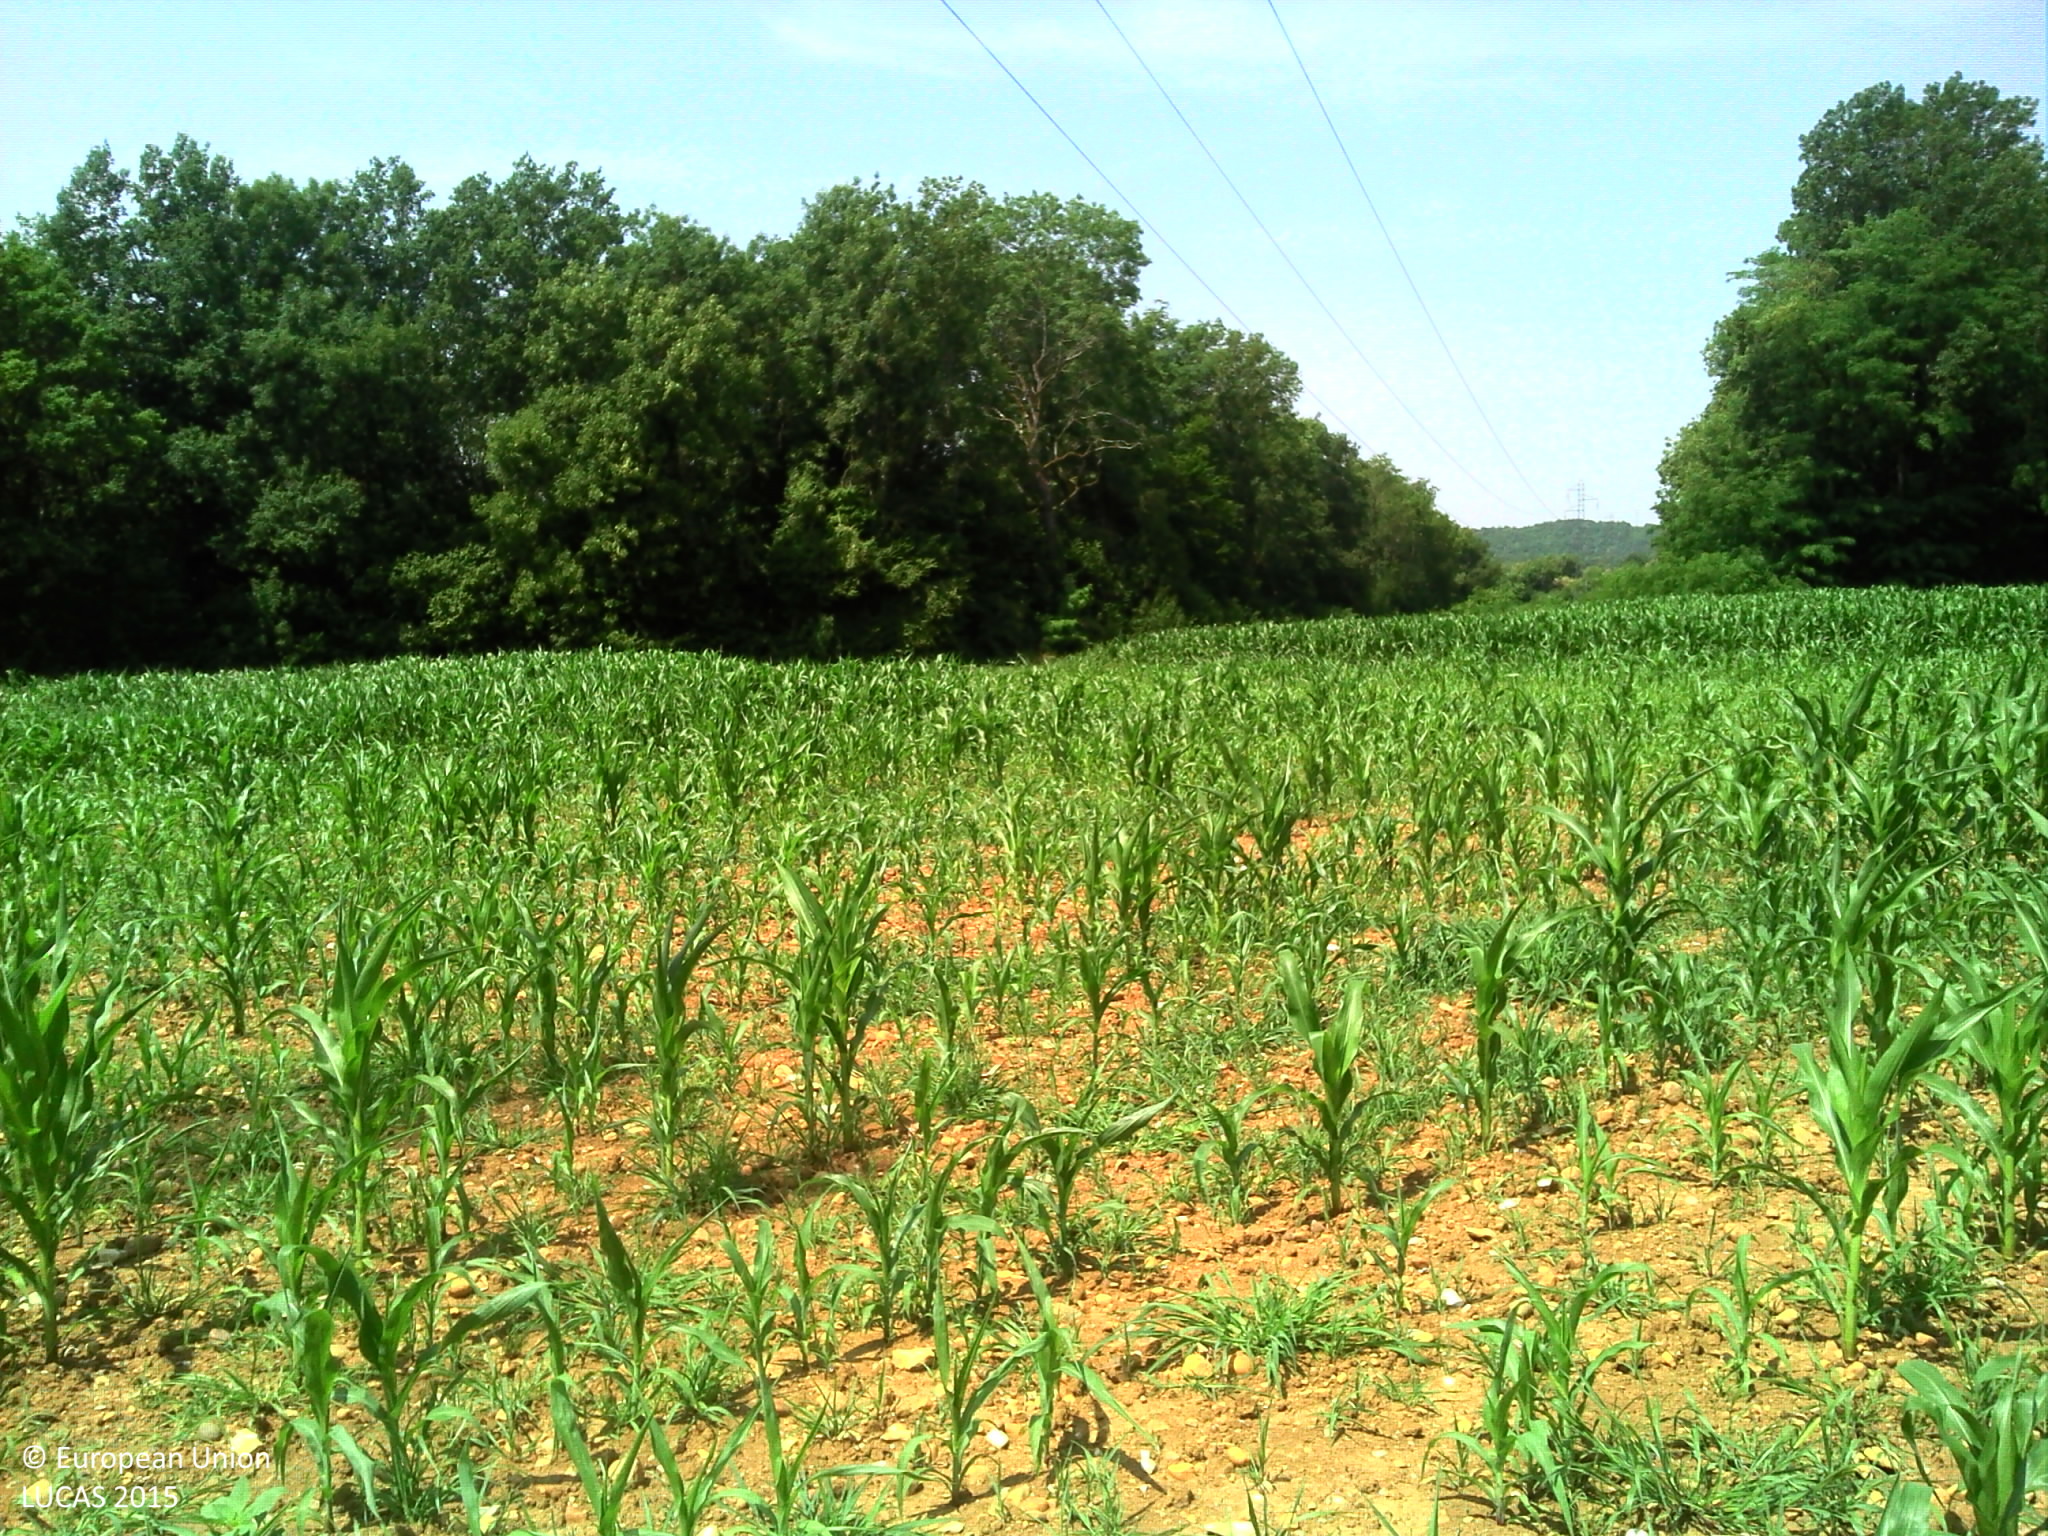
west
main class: Cropland
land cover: Maize
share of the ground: 25 - 50 %
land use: Agriculture (excluding fallow land and kitchen gardens)
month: July
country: FR
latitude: 45.8174
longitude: 5.3578
